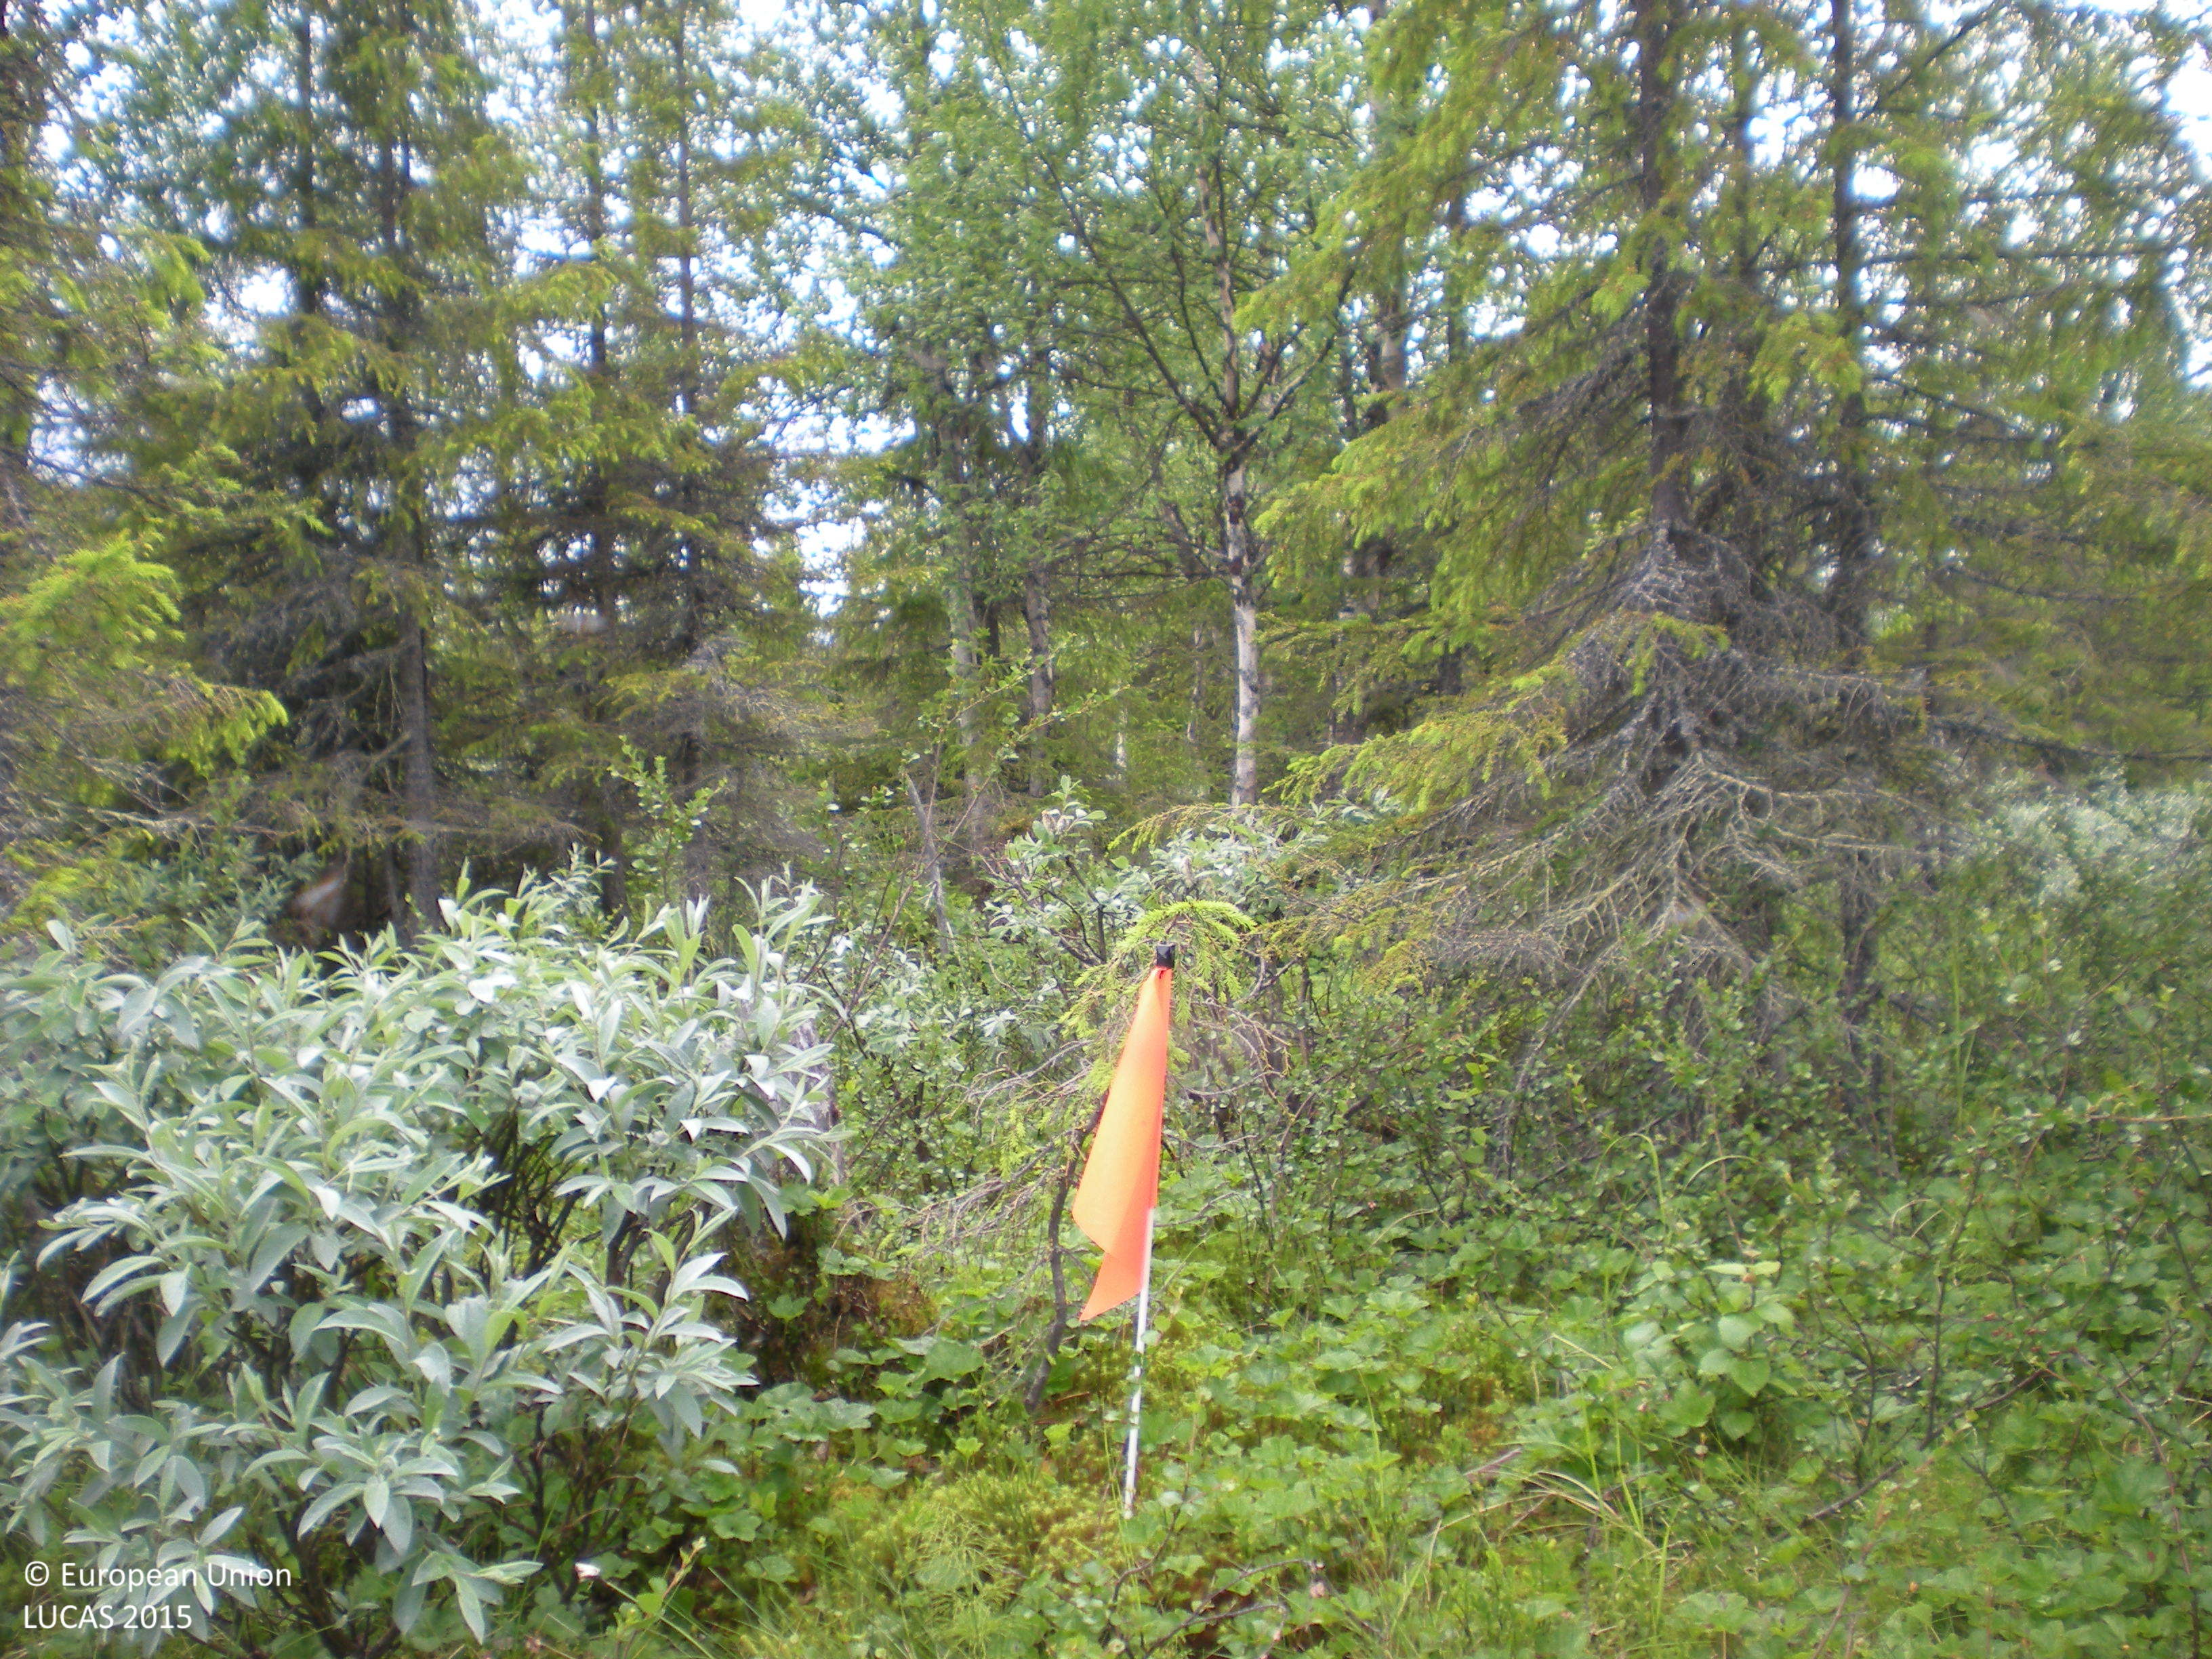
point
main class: Woodland
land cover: Spruce dominated mixed woodland
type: boreal forest
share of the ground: 50 - 75 %
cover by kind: coniferous forest trees 30 %, broadleaved forest trees 20 %, shrubs 20 %, herbaceous plants 20 %, lichens and mosses 10 %
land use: Forestry
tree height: > 5 m
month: July
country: SE
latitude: 65.9182
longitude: 17.3144
